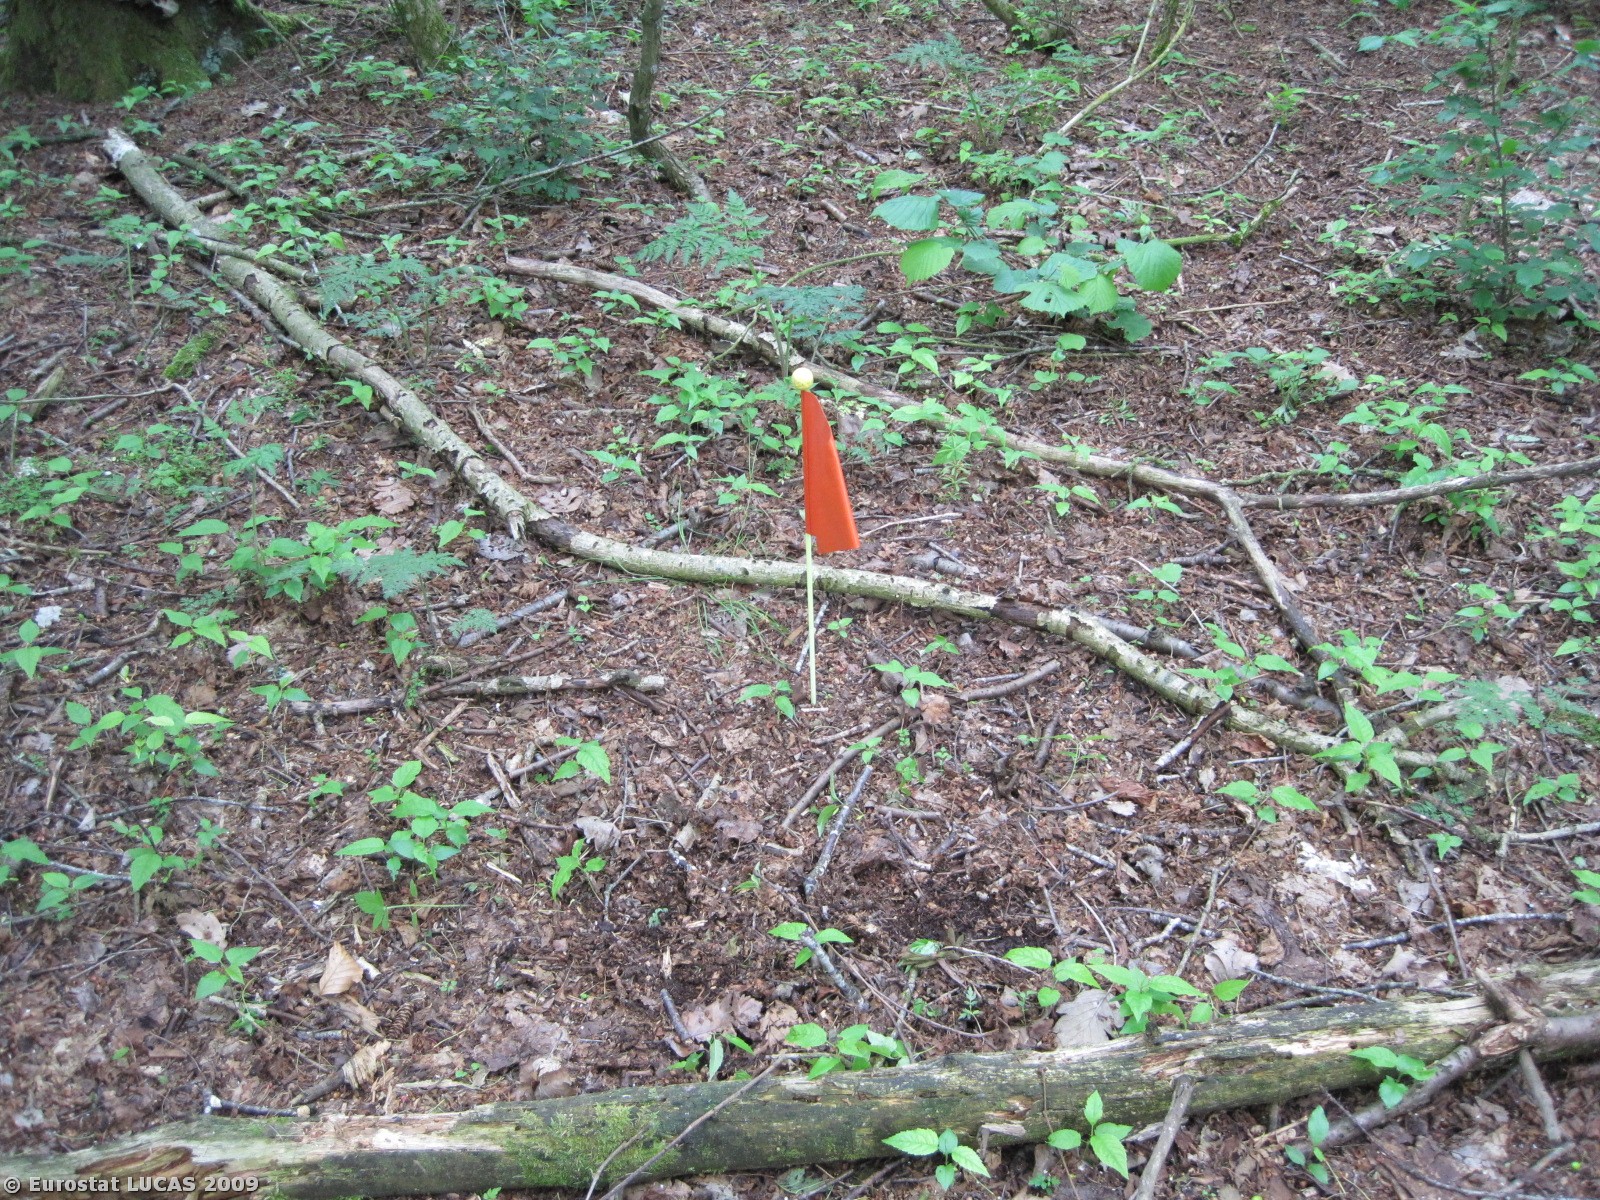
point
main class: Woodland
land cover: Broadleaved woodland
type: plantations and self-sown exotic forest
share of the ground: > 75 %
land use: Unused
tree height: > 5 m
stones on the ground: < 10 %
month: May
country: DK
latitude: 56.7450
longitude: 10.0163
